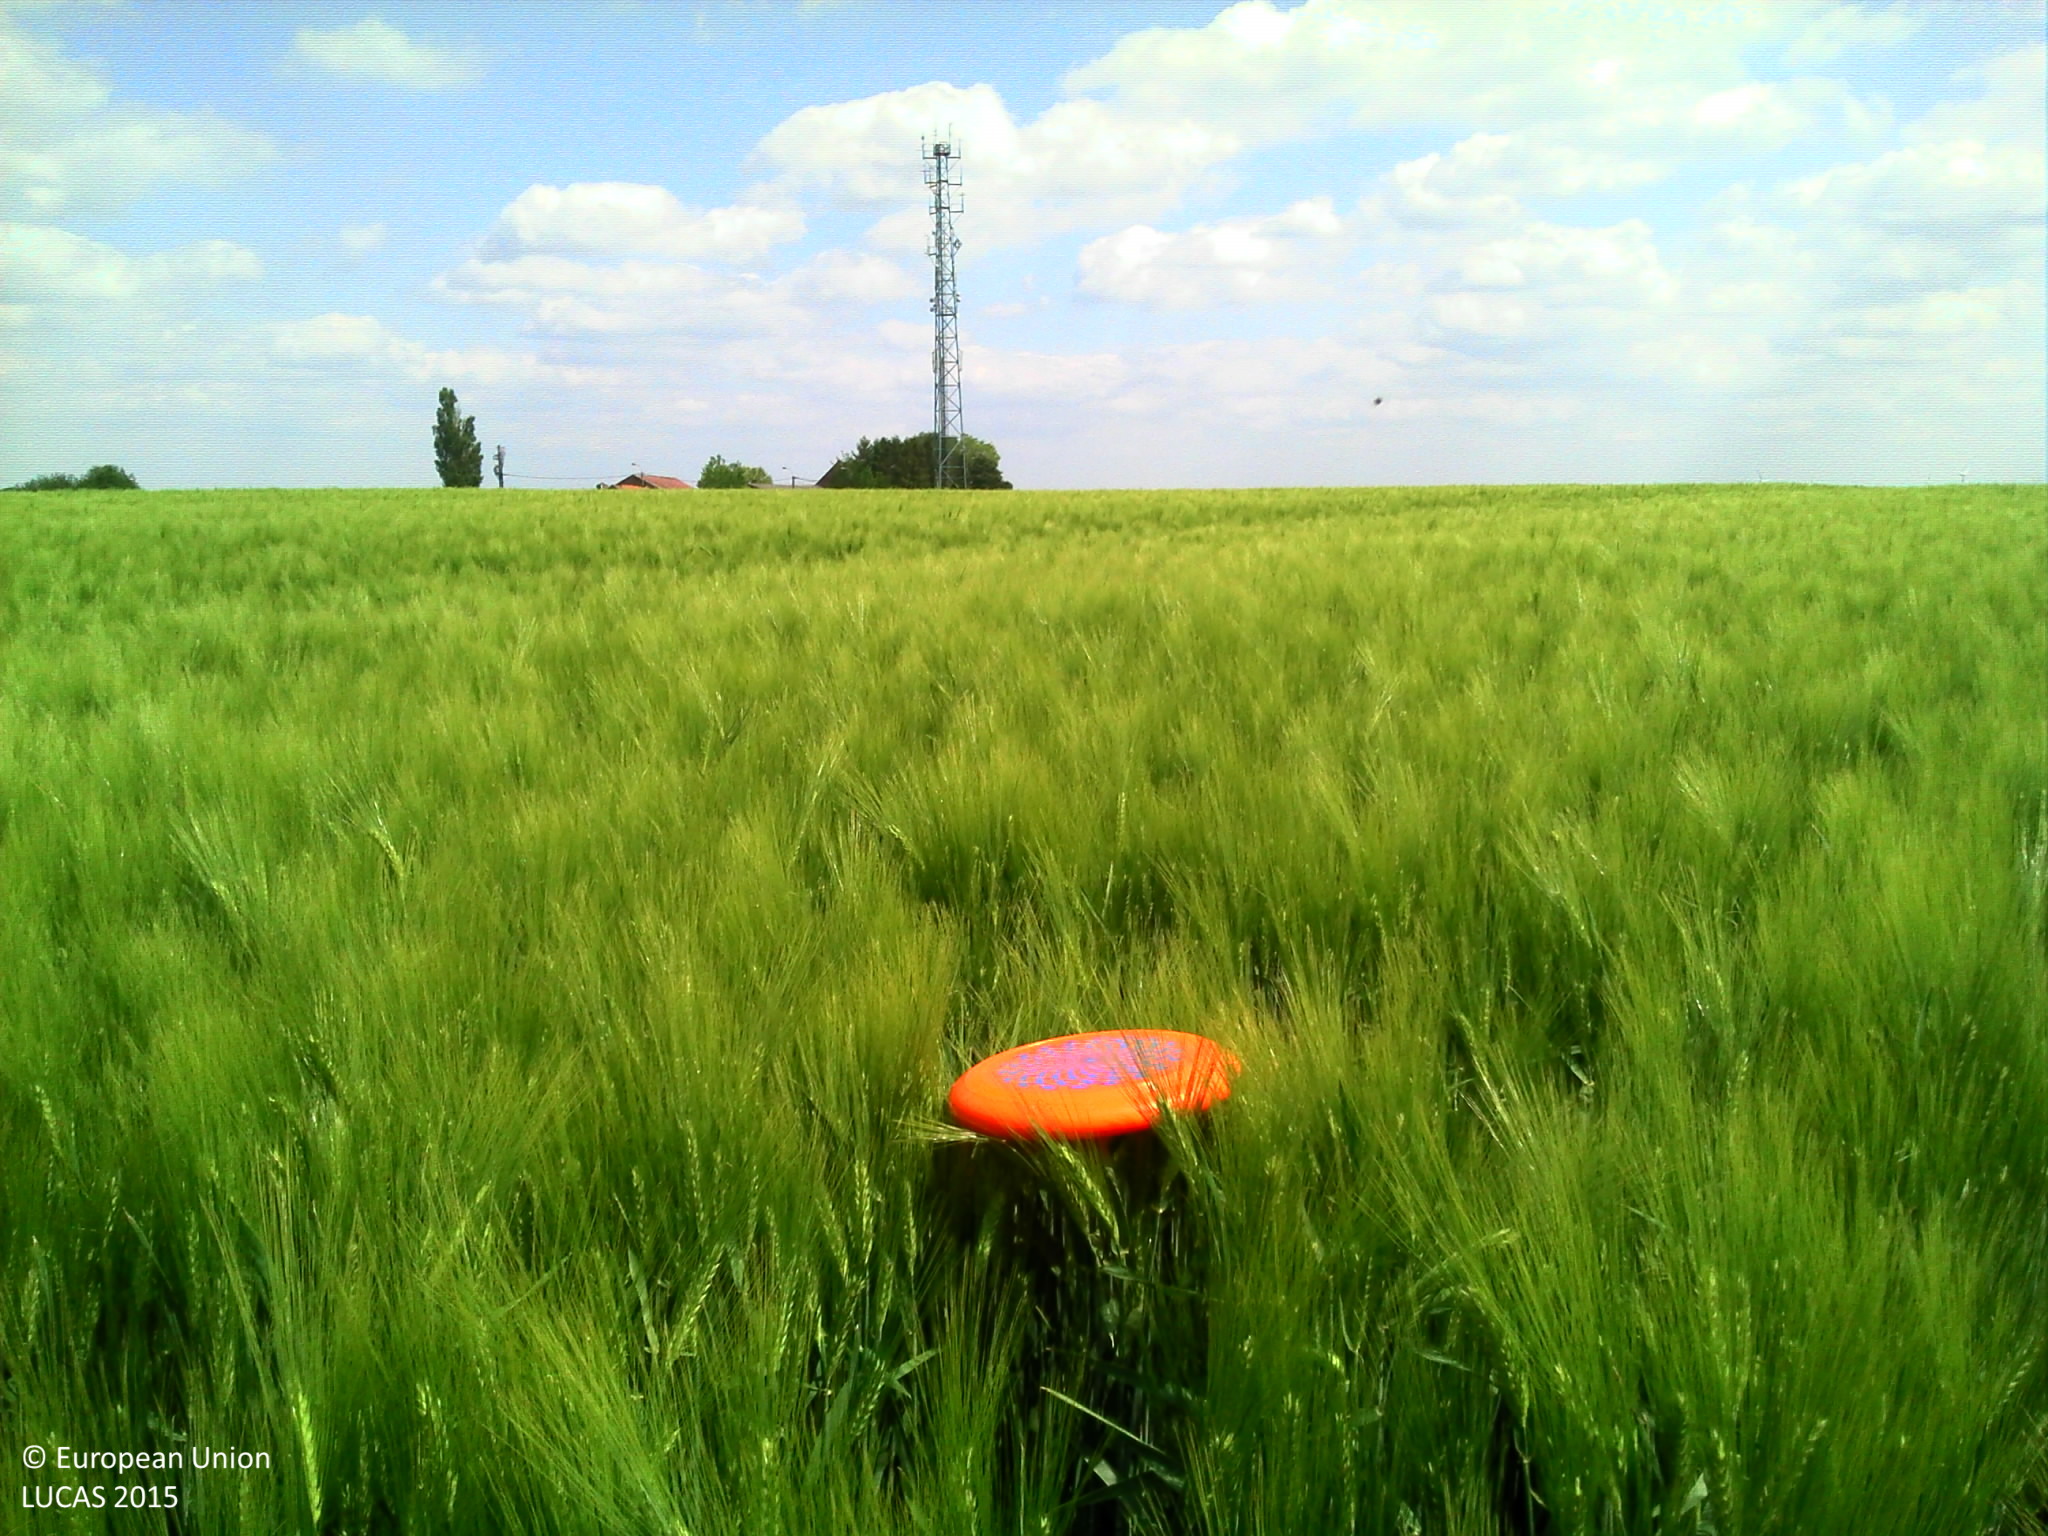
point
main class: Cropland
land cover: Barley
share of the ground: > 75 %
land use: Agriculture (excluding fallow land and kitchen gardens)
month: May
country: BE
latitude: 50.6227
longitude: 5.1775
